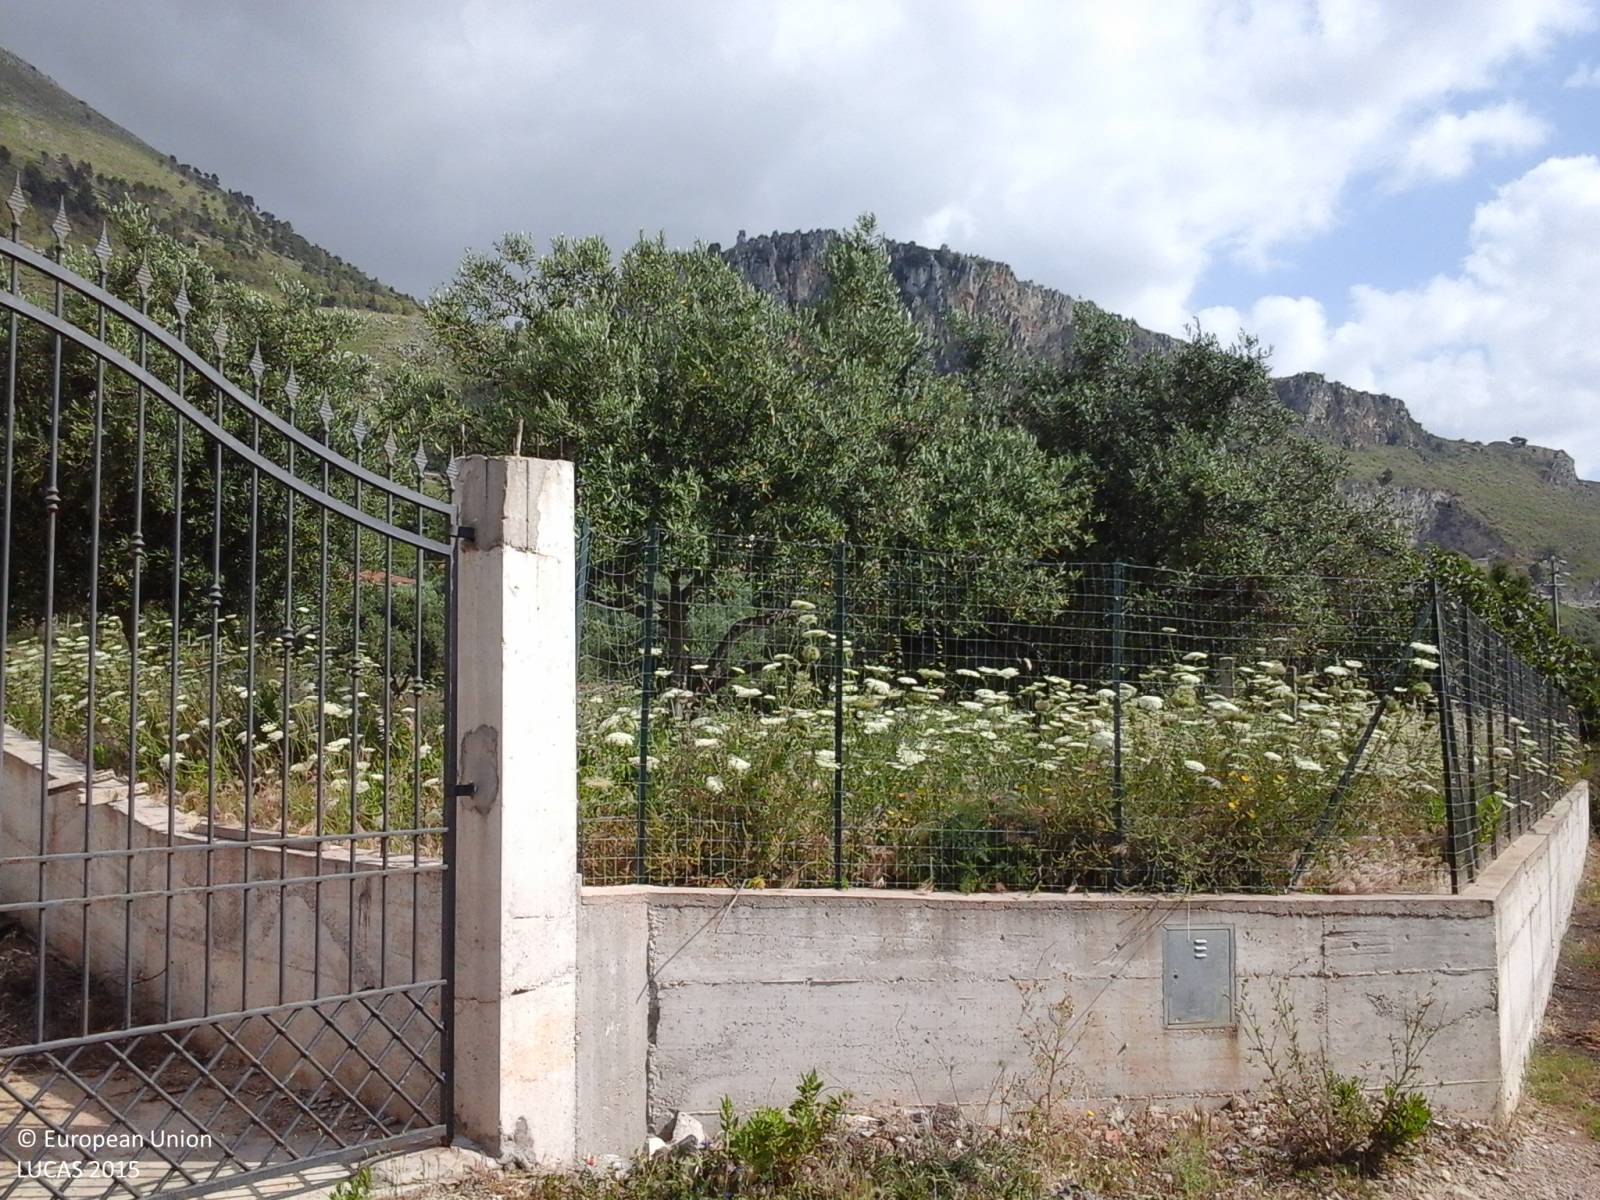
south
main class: Cropland
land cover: Vineyards
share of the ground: 25 - 50 %
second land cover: Olive groves
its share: 25 - 50 %
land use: Agriculture (excluding fallow land and kitchen gardens)
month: June
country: IT
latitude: 38.0584
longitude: 13.1574
